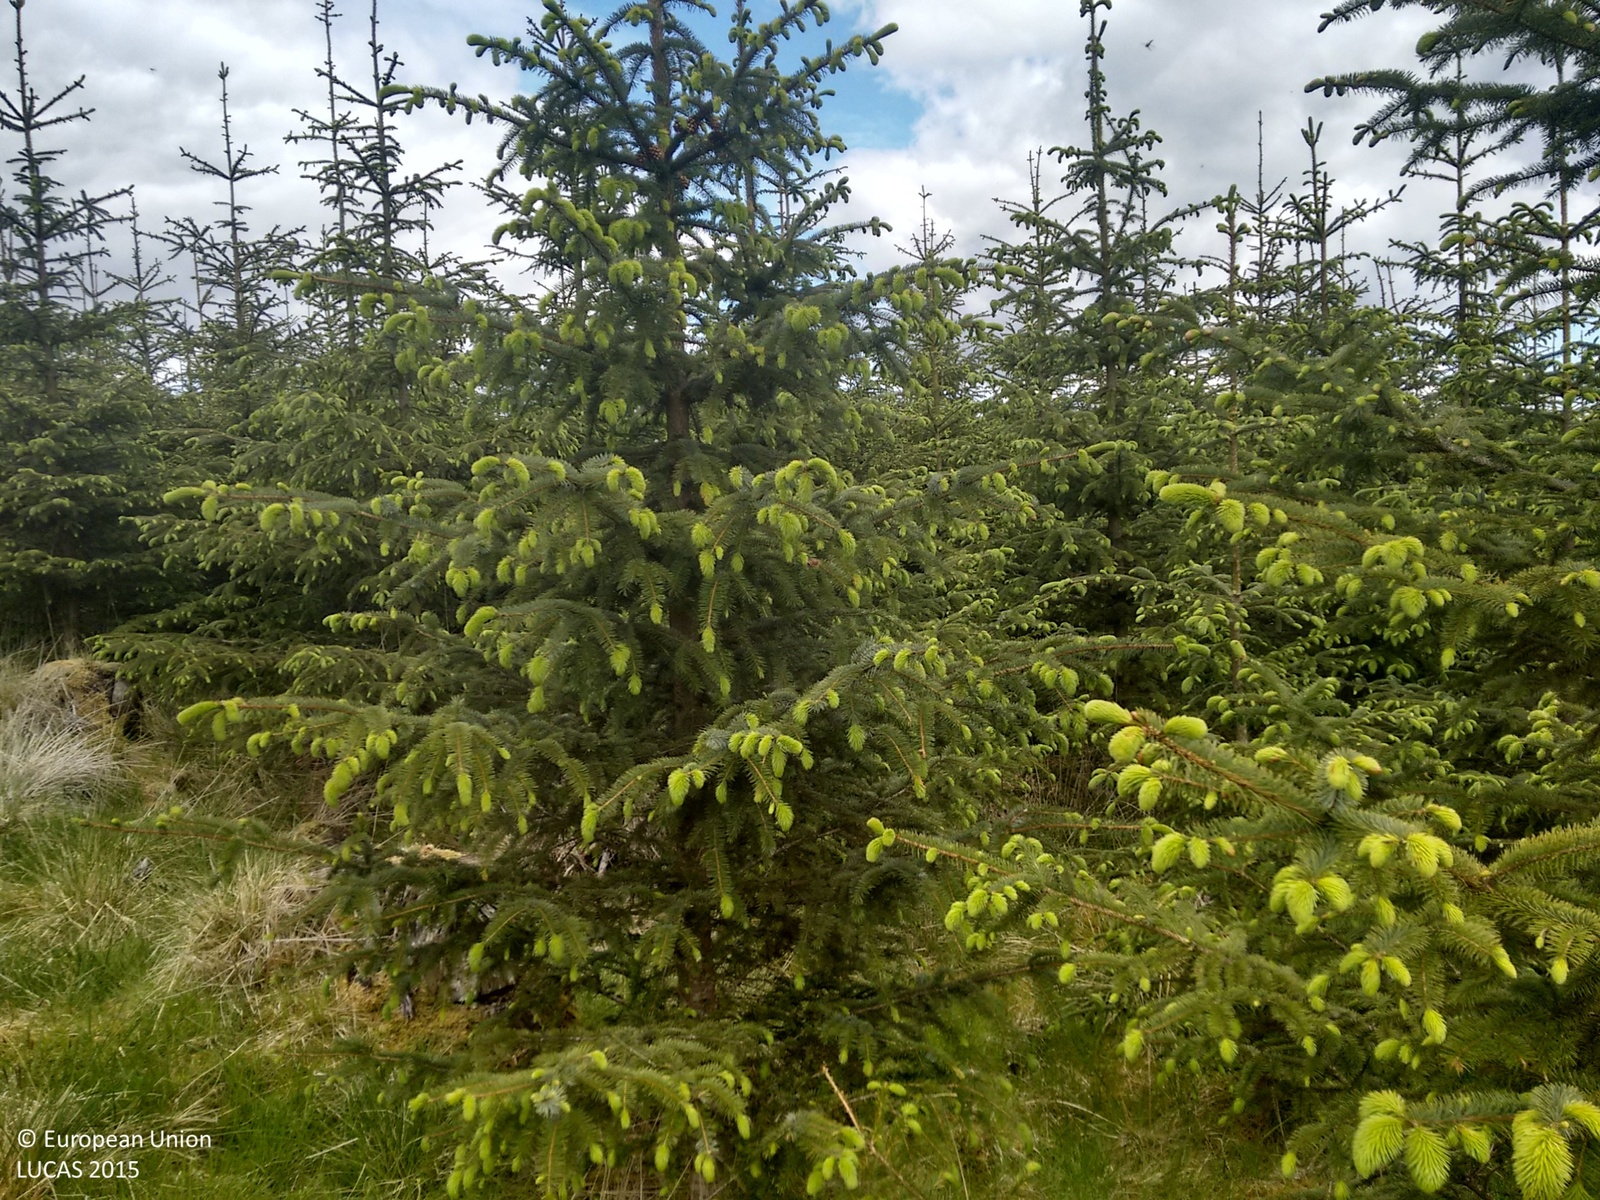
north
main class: Woodland
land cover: Spruce dominated coniferous woodland
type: exotic forest
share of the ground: > 75 %
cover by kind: coniferous forest trees 85 %, herbaceous plants 15 %
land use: Forestry
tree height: < 5 m
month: June
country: GB
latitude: 55.7345
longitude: -3.2438
